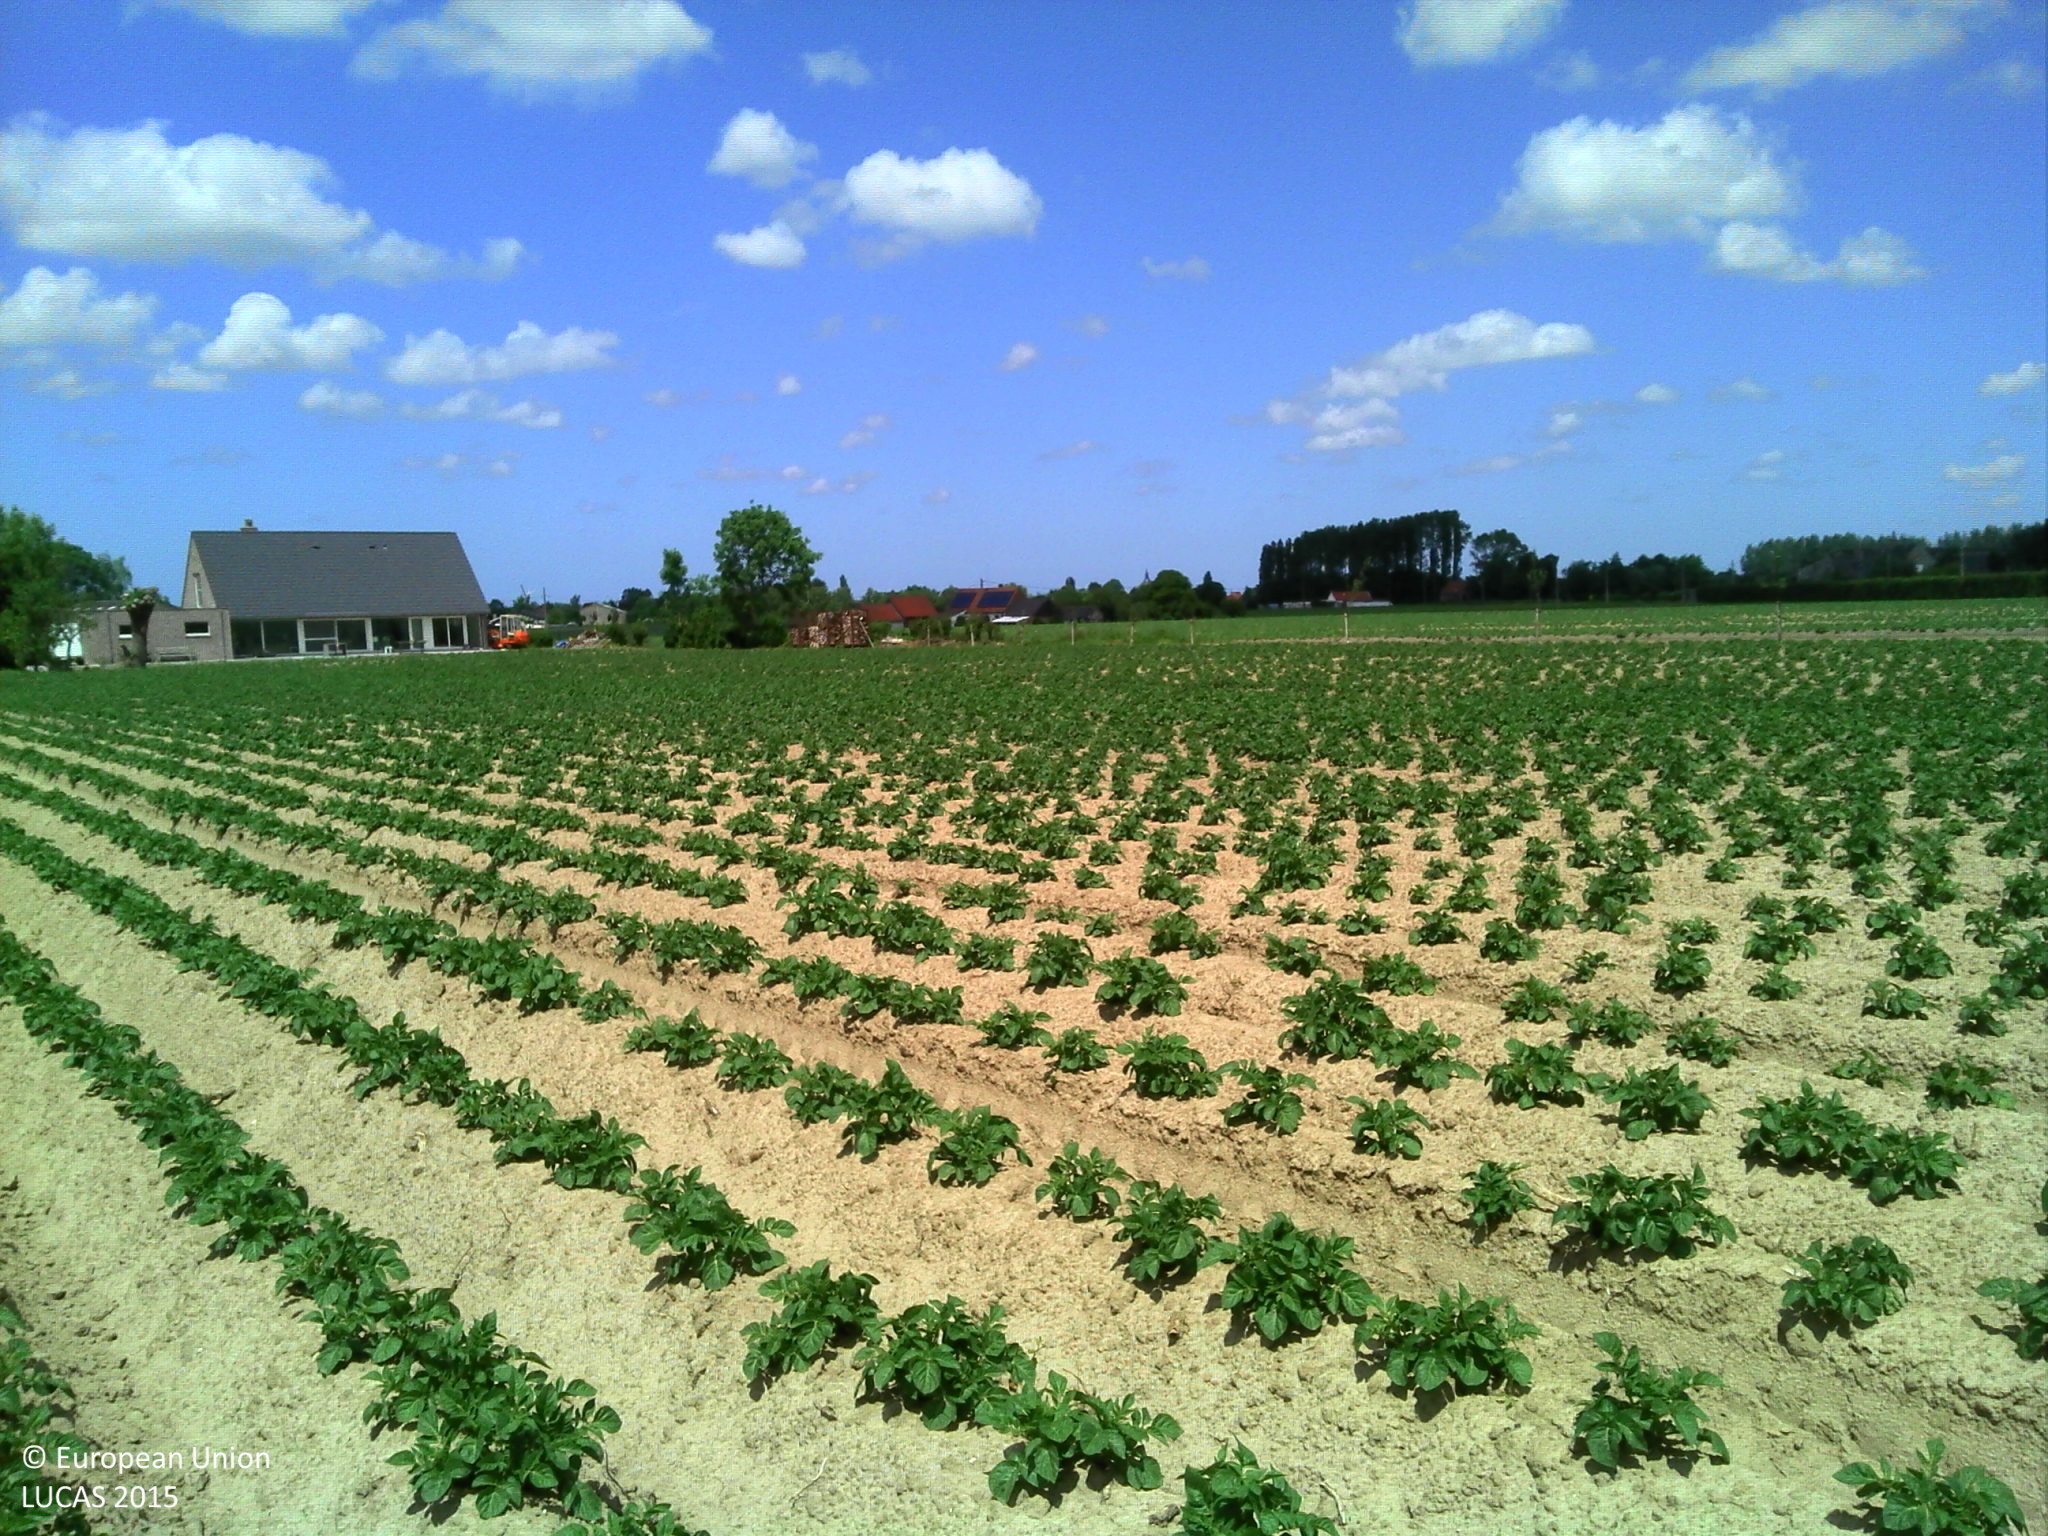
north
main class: Cropland
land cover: Potatoes
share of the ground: 10 - 25 %
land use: Agriculture (excluding fallow land and kitchen gardens)
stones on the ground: < 10 %
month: June
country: BE
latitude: 50.8369
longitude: 2.7324
